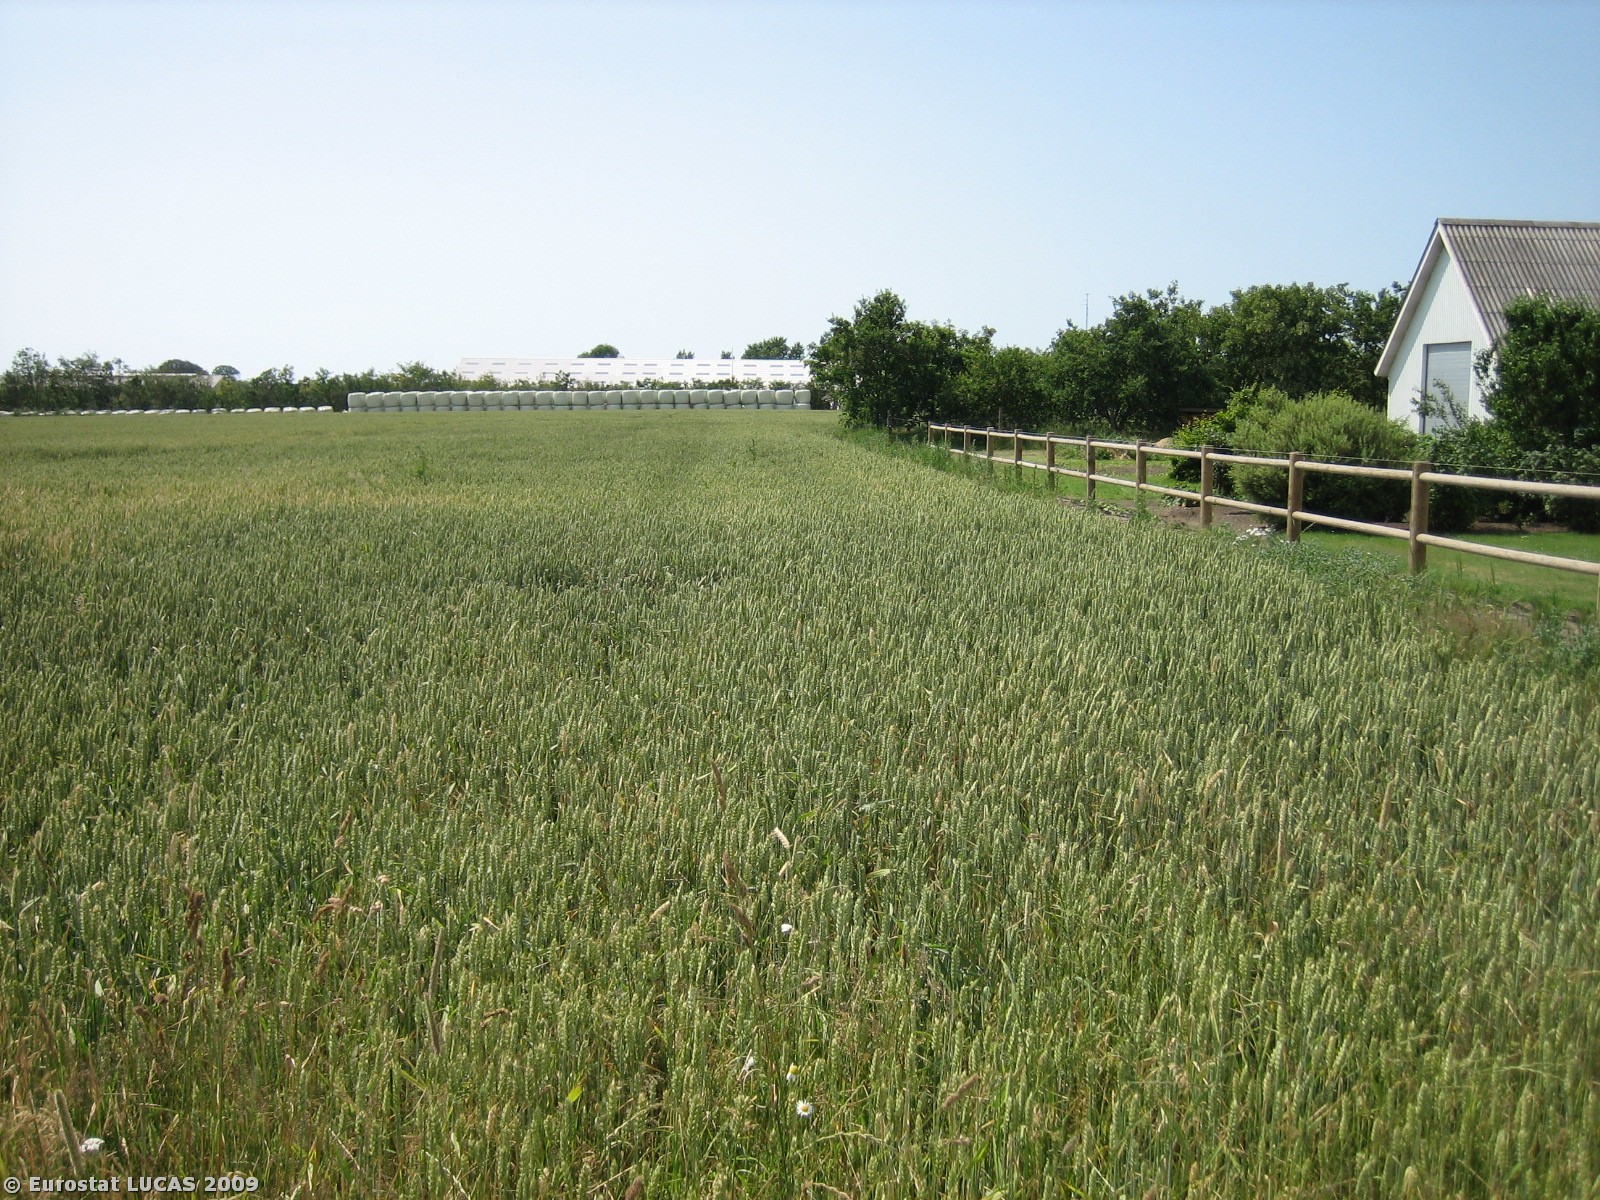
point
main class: Cropland
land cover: Common wheat
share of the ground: > 75 %
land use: Agriculture (excluding fallow land and kitchen gardens)
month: July
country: DK
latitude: 55.3904
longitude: 8.7224
